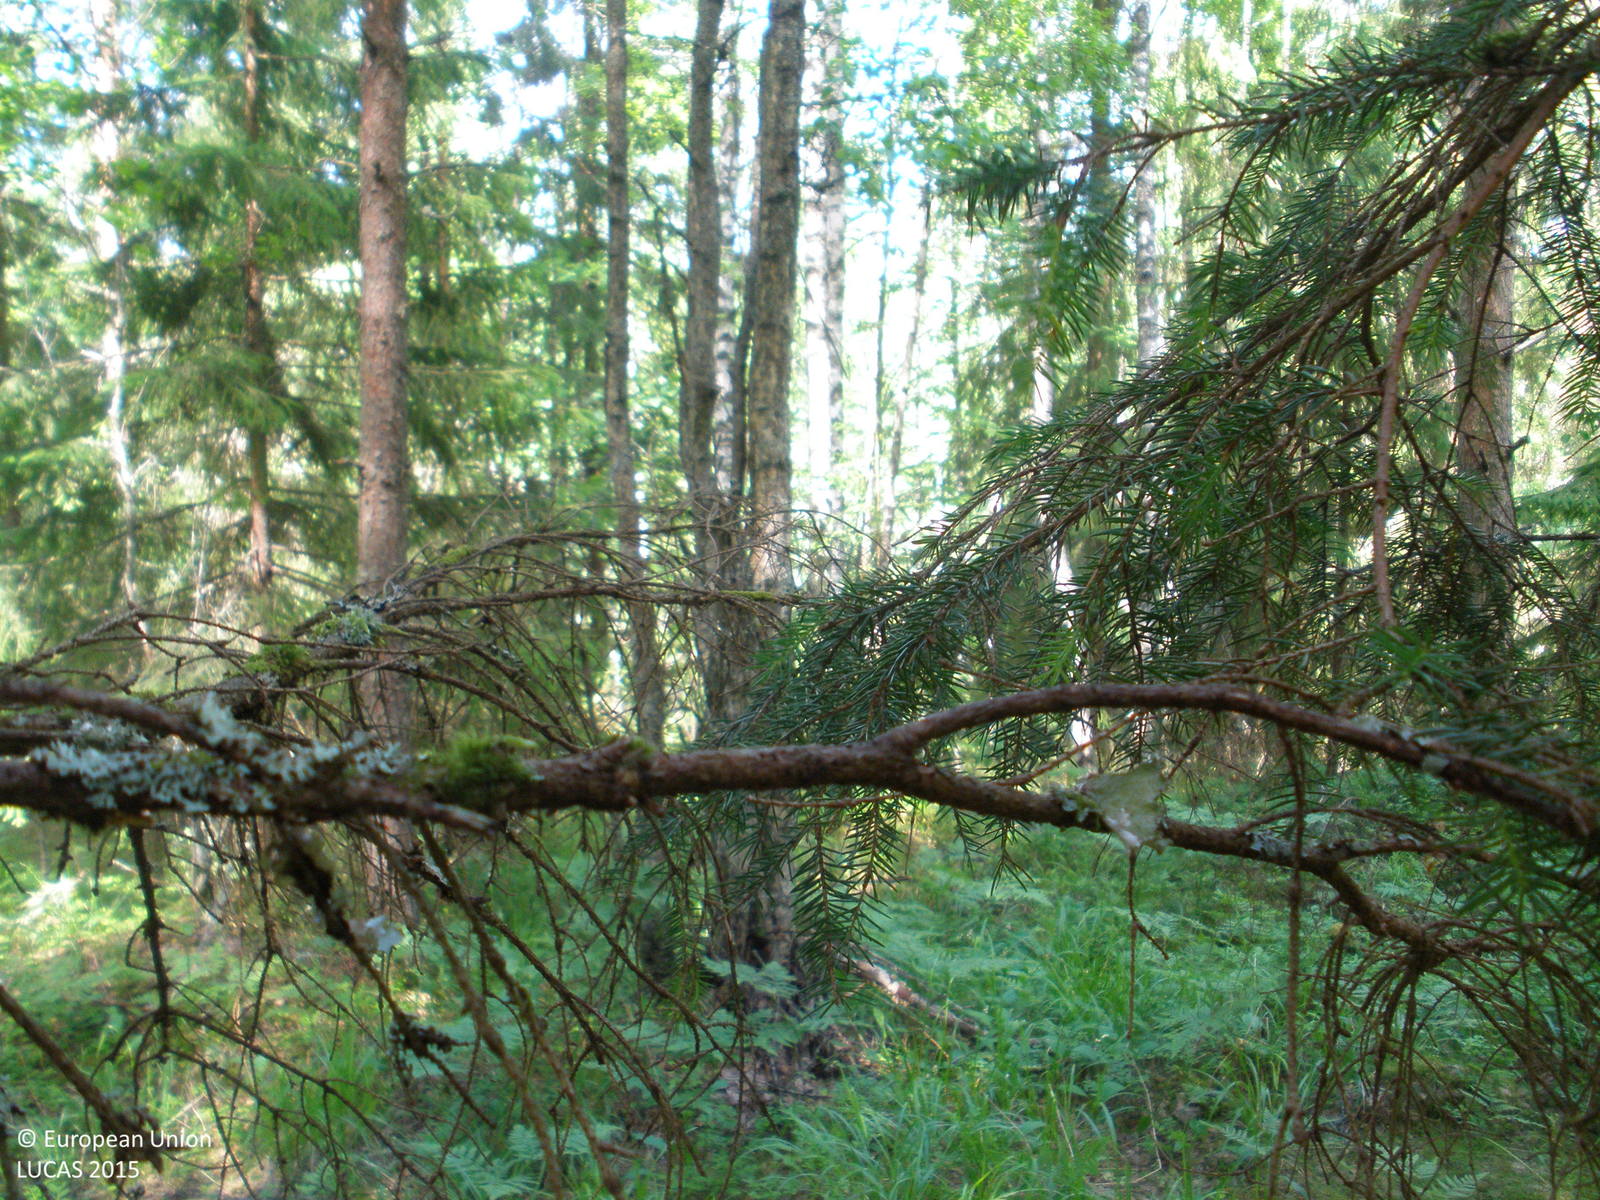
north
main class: Woodland
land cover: Pine dominated mixed woodland
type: boreal forest
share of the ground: > 75 %
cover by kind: coniferous forest trees 55 %, broadleaved forest trees 30 %, herbaceous plants 10 %, lichens and mosses 5 %
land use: Forestry
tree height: > 5 m
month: June
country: FI
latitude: 61.0240
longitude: 24.6693
